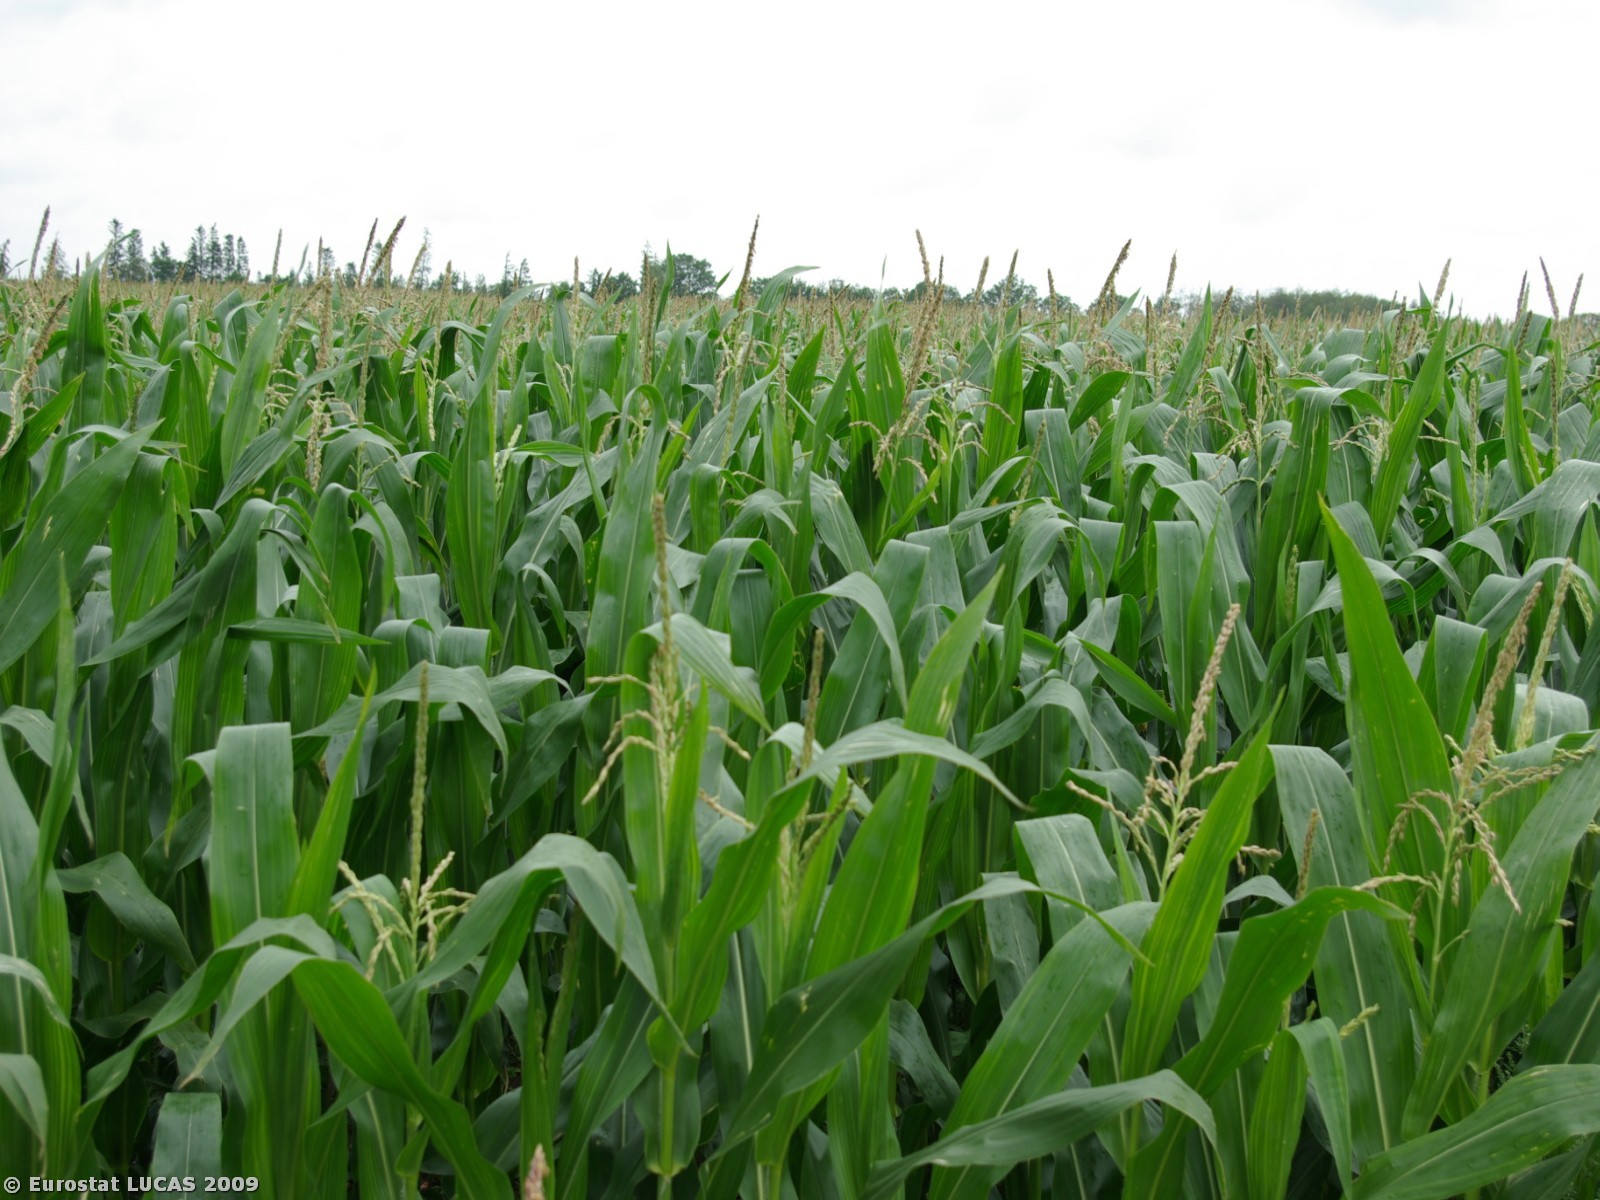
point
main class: Cropland
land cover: Maize
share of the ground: > 75 %
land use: Agriculture (excluding fallow land and kitchen gardens)
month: July
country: DK
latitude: 55.1223
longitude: 8.8876
